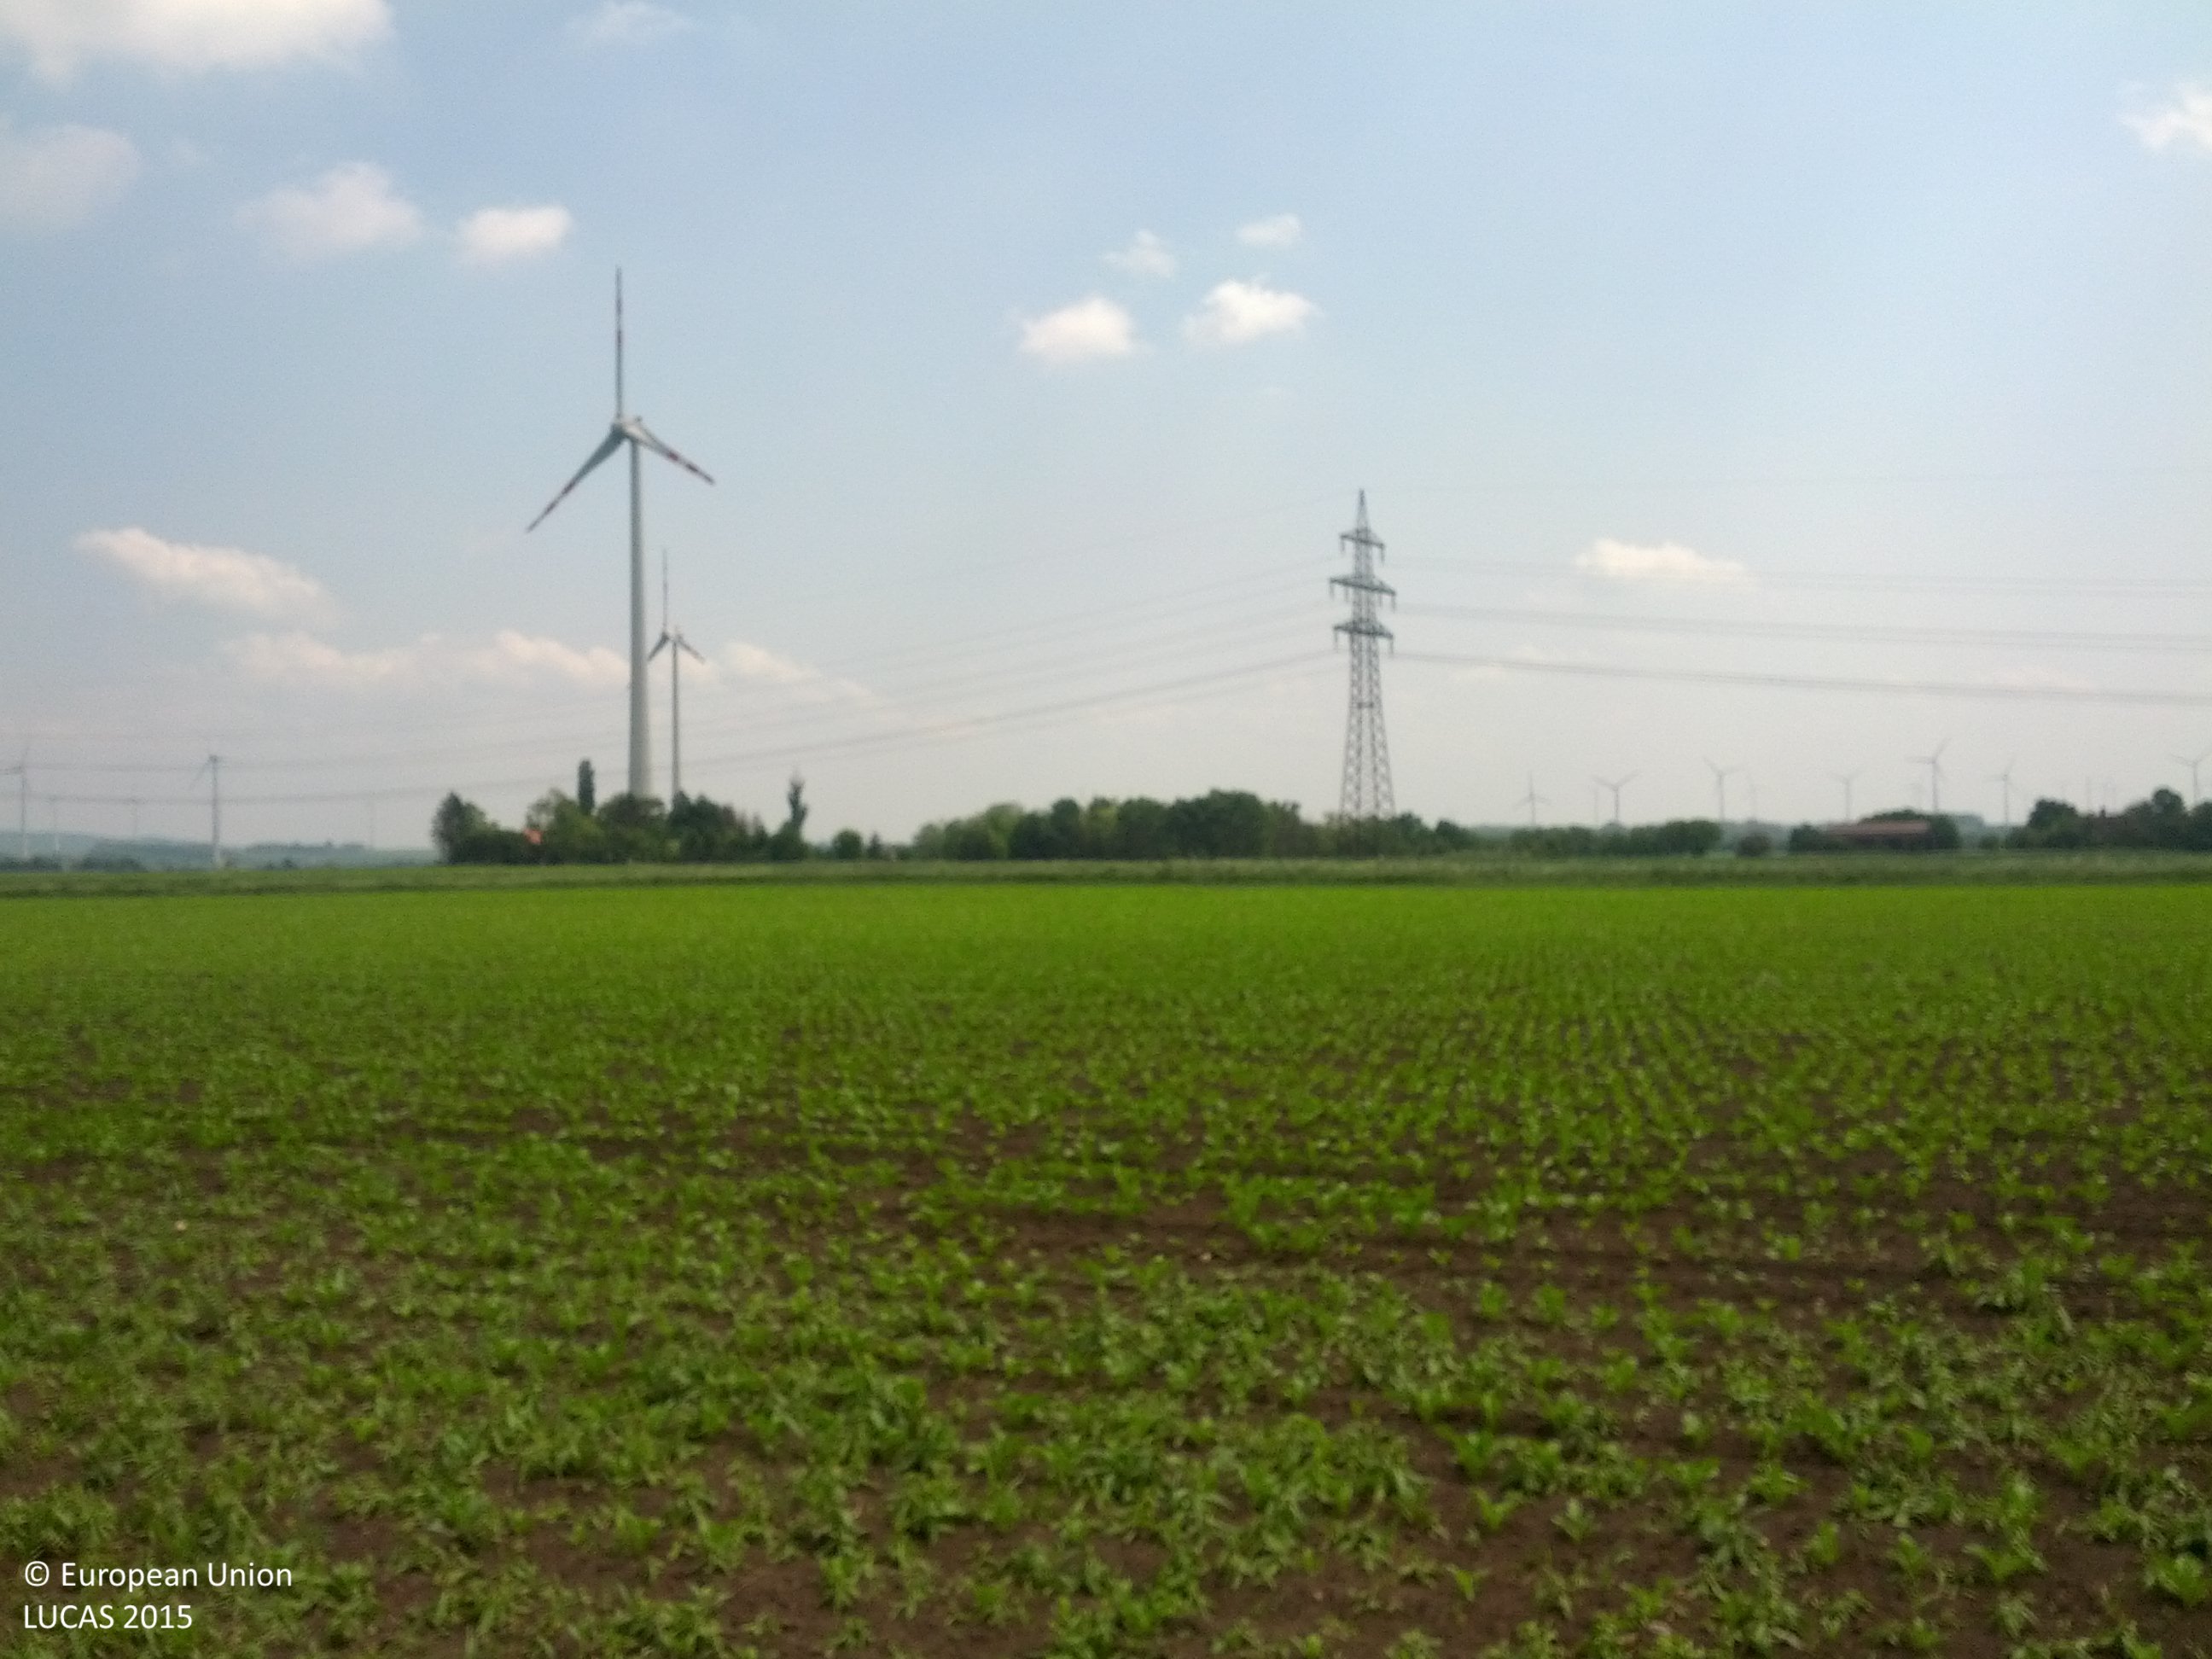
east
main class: Cropland
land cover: Sugar beet
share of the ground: 10 - 25 %
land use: Agriculture (excluding fallow land and kitchen gardens)
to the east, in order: Sugar beet; Grassland without tree/shrub cover; Triticale; Grass margins; Tracks; Grass margins; Potatoes
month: May
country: AT
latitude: 48.0833
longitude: 16.8395
